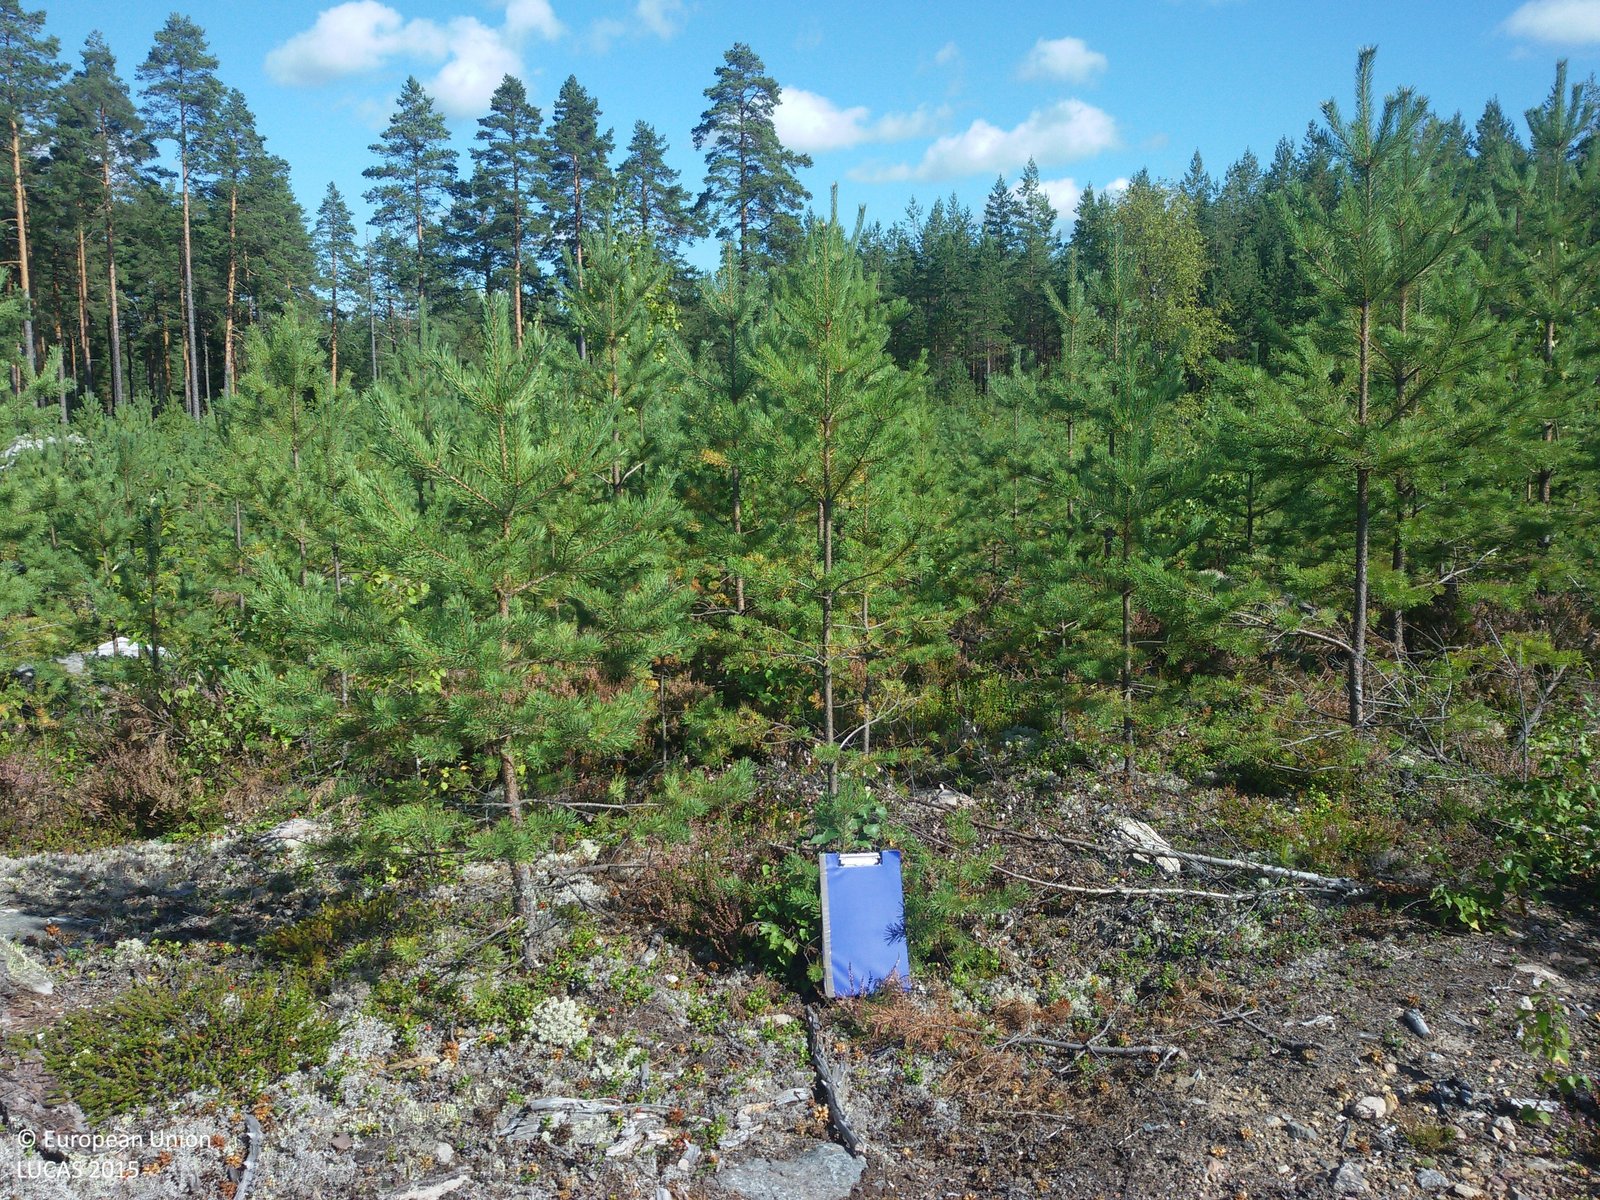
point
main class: Woodland
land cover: Pine dominated coniferous woodland
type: boreal forest
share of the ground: 50 - 75 %
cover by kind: coniferous forest trees 60 %, herbaceous plants 20 %, broadleaved forest trees 10 %, lichens and mosses 10 %
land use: Forestry
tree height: < 5 m
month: August
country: SE
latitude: 60.6608
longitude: 15.7139
